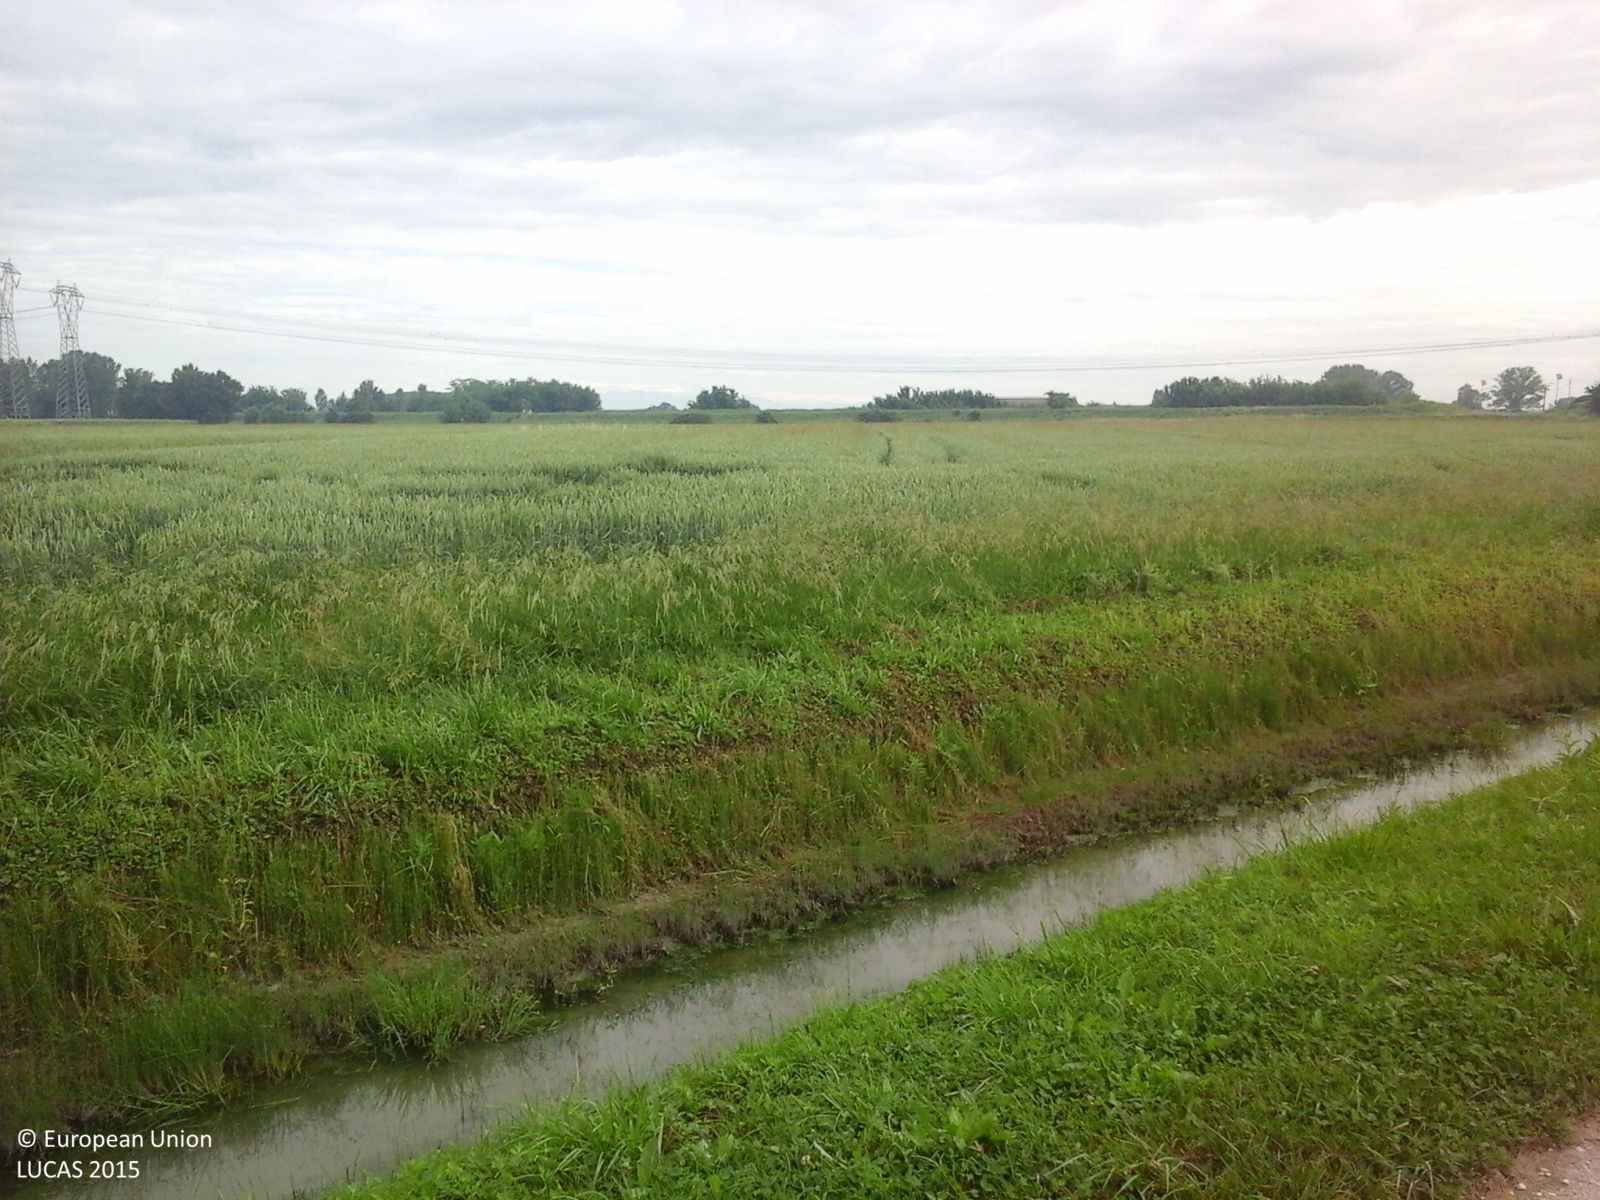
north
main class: Cropland
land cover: Temporary grasslands
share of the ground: > 75 %
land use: Agriculture (excluding fallow land and kitchen gardens)
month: May
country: IT
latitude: 45.0105
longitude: 11.2284
